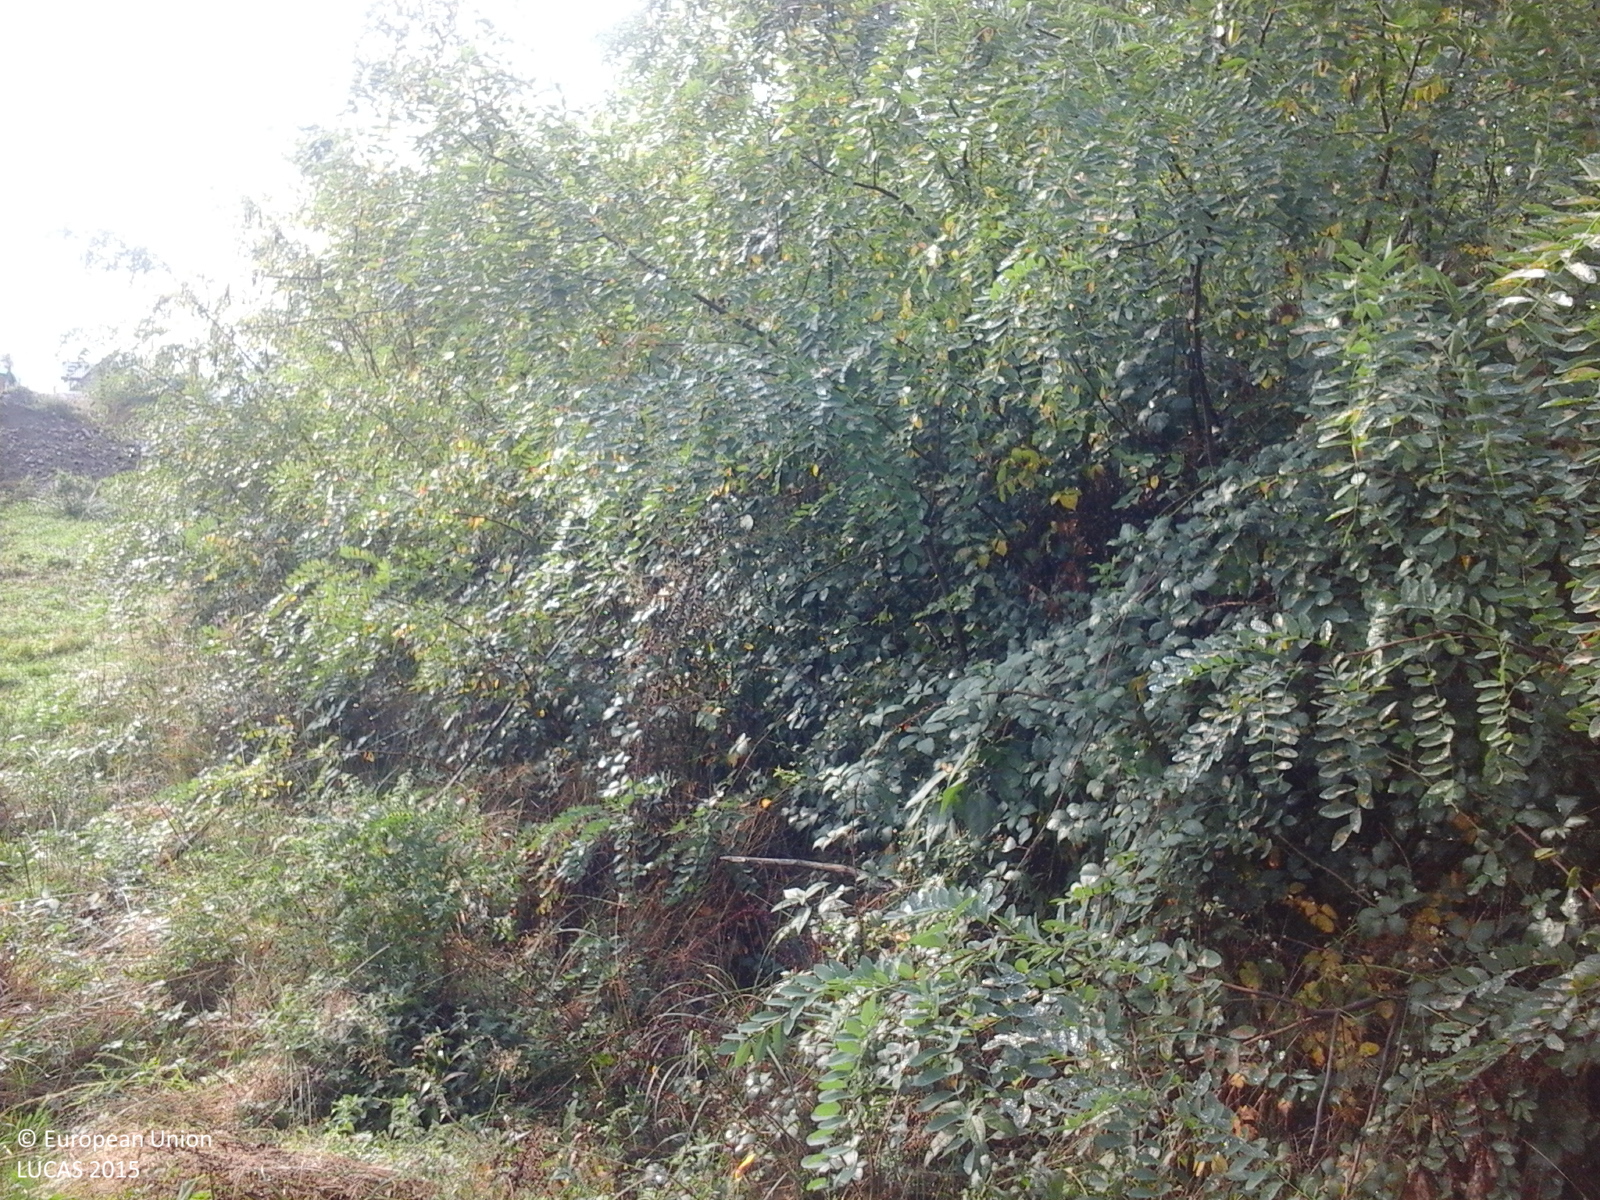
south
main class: Woodland
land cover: Broadleaved woodland
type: exotic forest
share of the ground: > 75 %
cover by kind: broadleaved forest trees 100 %
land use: Forestry
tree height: > 5 m
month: September
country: RO
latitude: 45.5205
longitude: 22.3723
